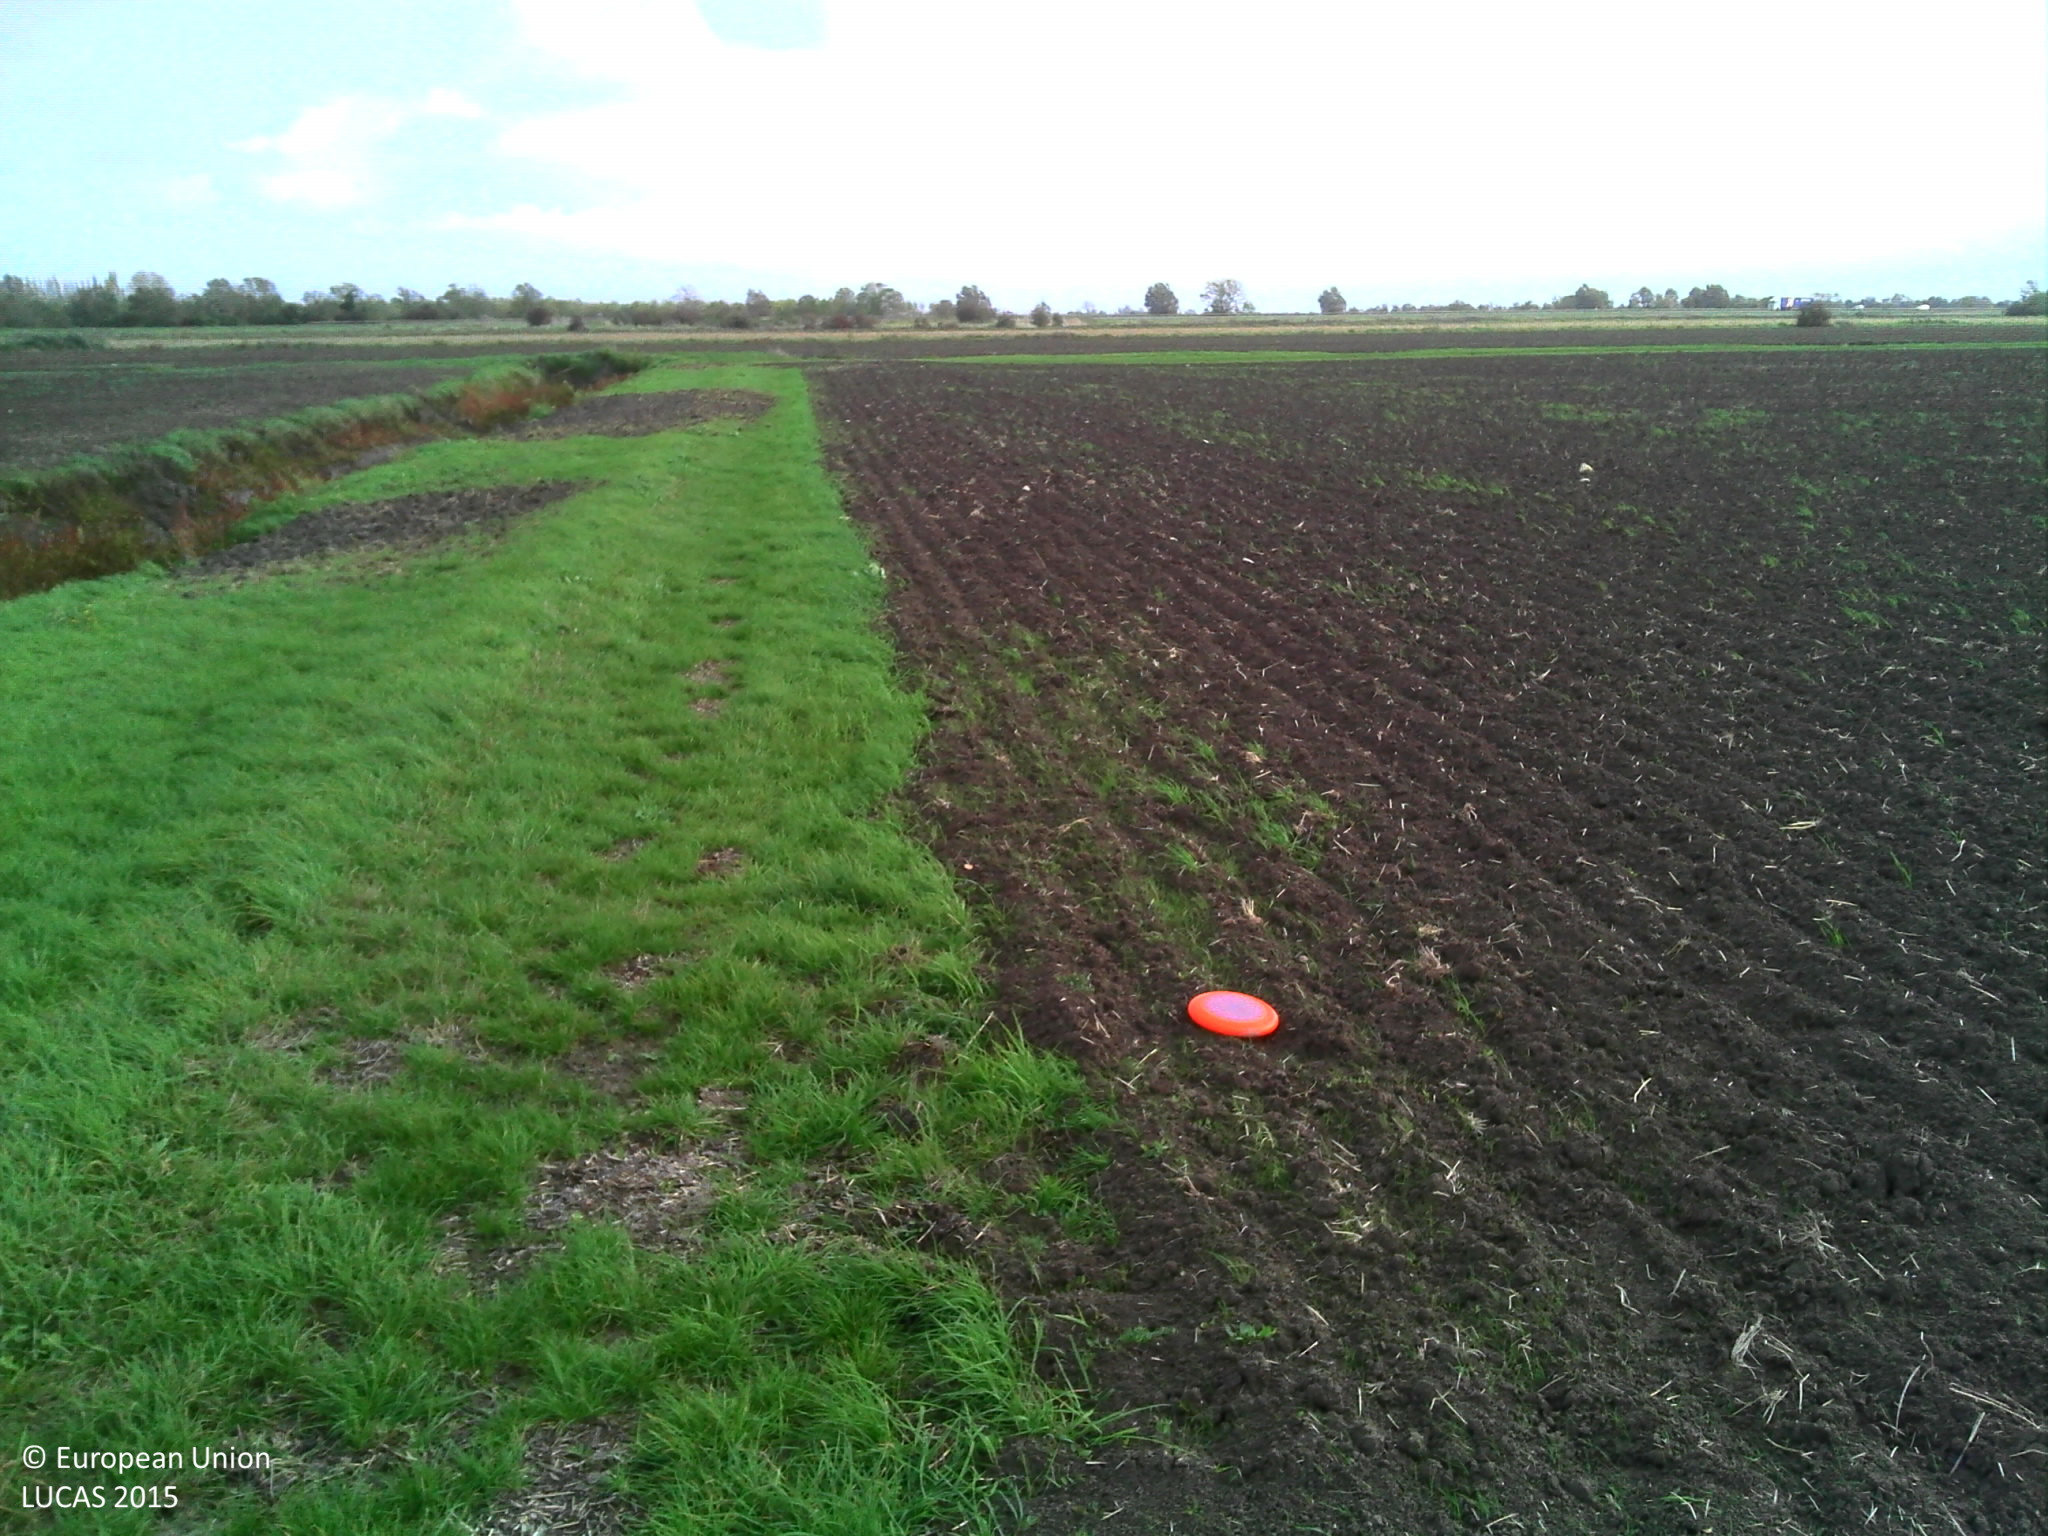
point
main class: Grassland
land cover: Grassland without tree/shrub cover
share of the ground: < 10 %
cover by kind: herbaceous plants 100 %
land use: Agriculture (excluding fallow land and kitchen gardens)
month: October
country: FR
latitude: 46.3718
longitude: -1.0951
